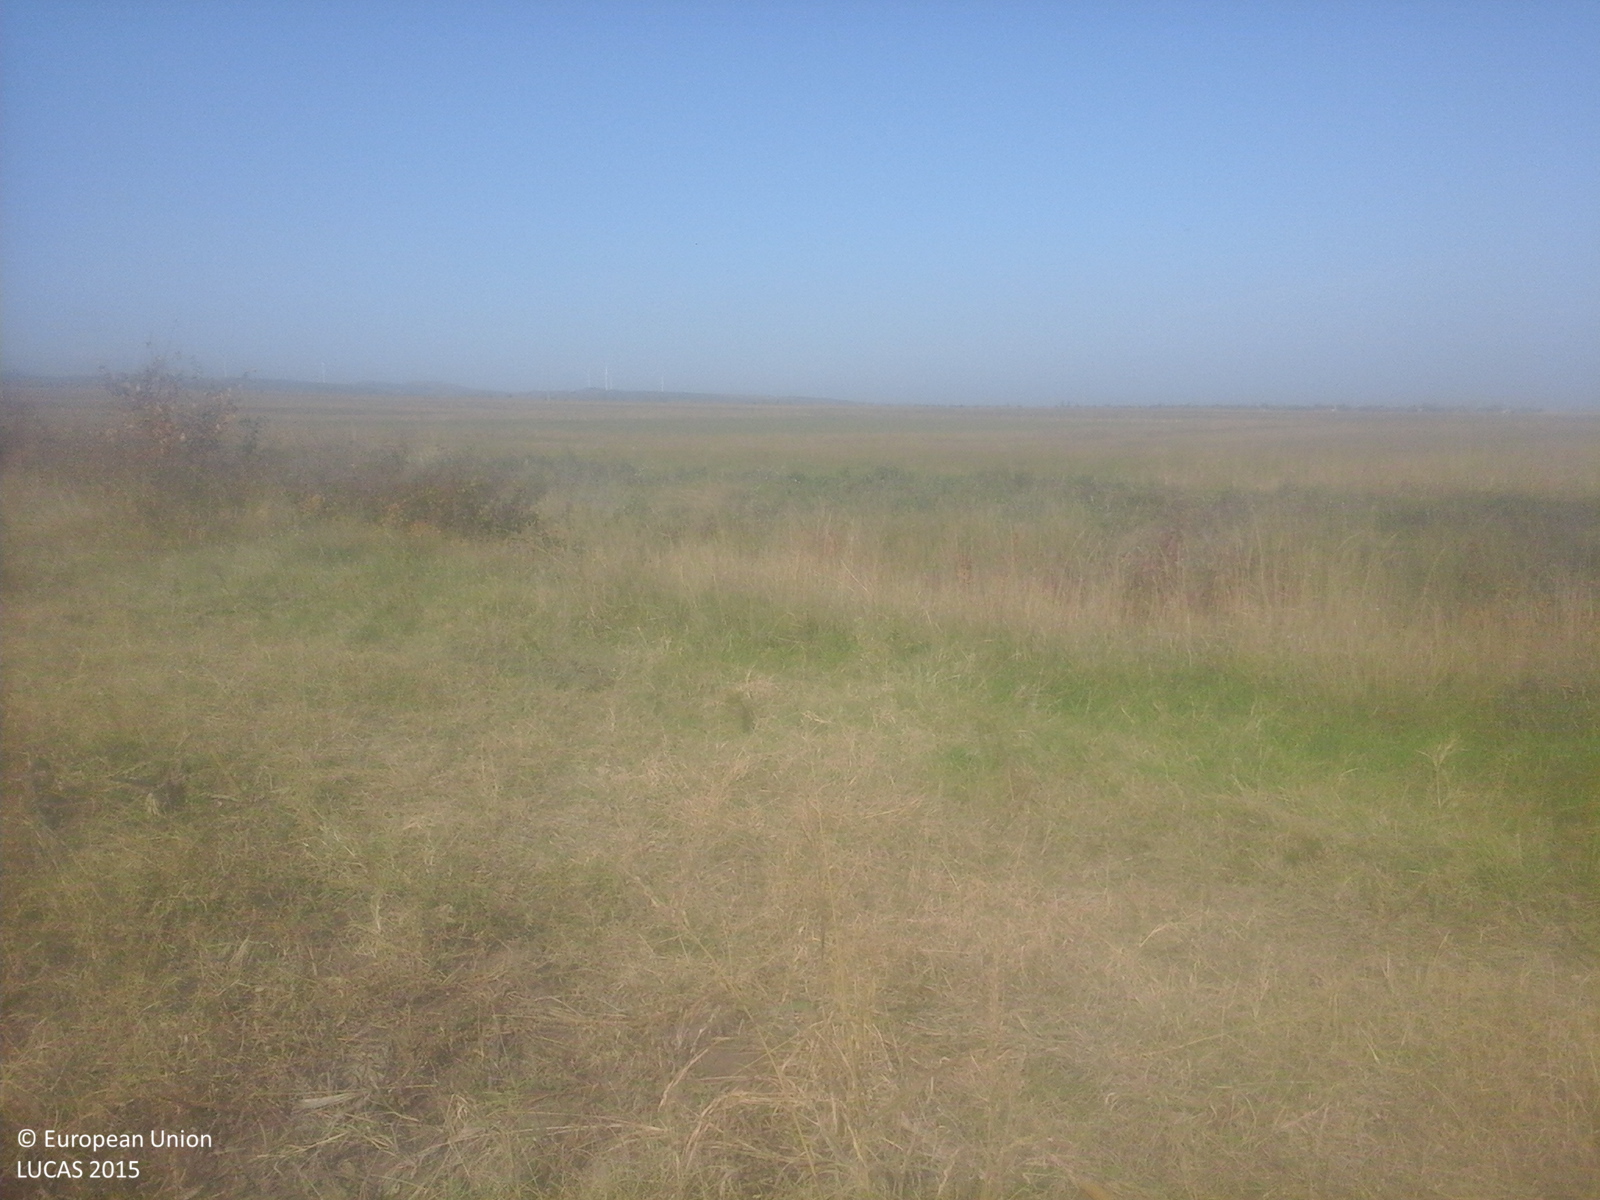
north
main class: Cropland
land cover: Maize
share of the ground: 10 - 25 %
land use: Agriculture (excluding fallow land and kitchen gardens)
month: October
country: RO
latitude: 45.3499
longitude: 26.9723
